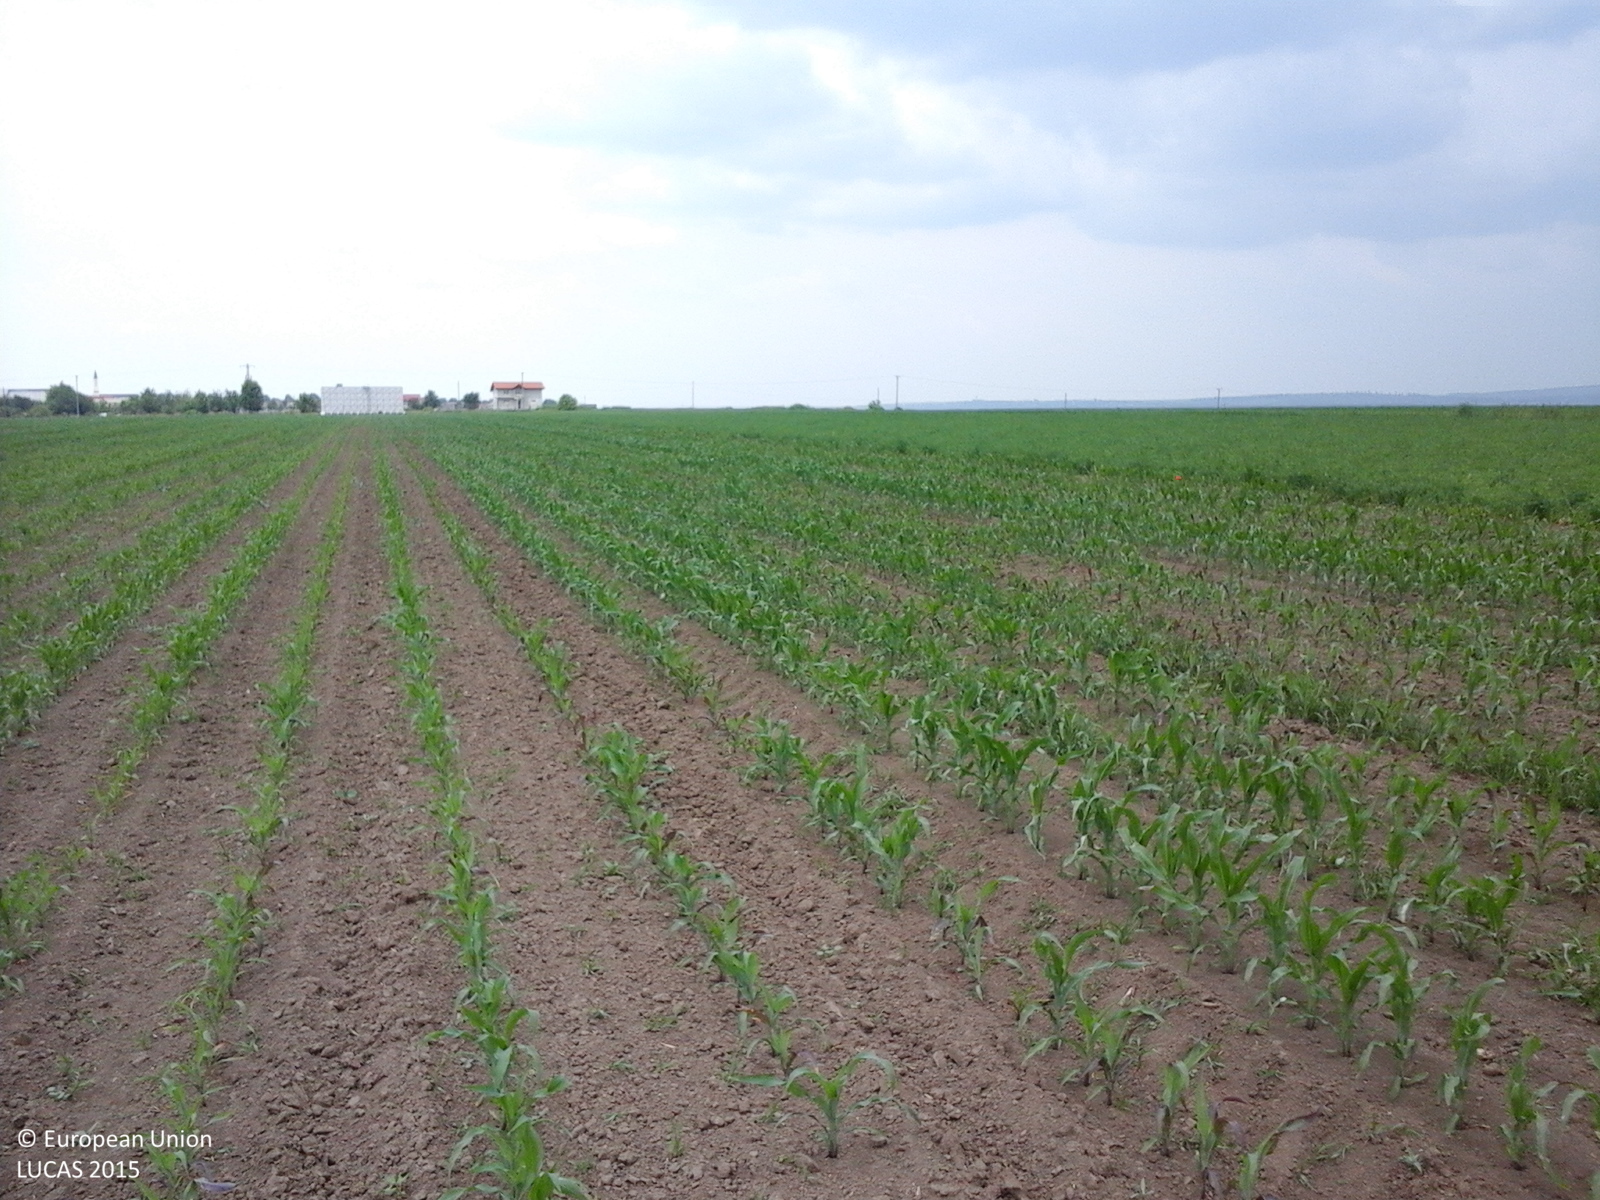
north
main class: Cropland
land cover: Maize
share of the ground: 25 - 50 %
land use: Agriculture (excluding fallow land and kitchen gardens)
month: June
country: RO
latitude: 46.9779
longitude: 26.9103
